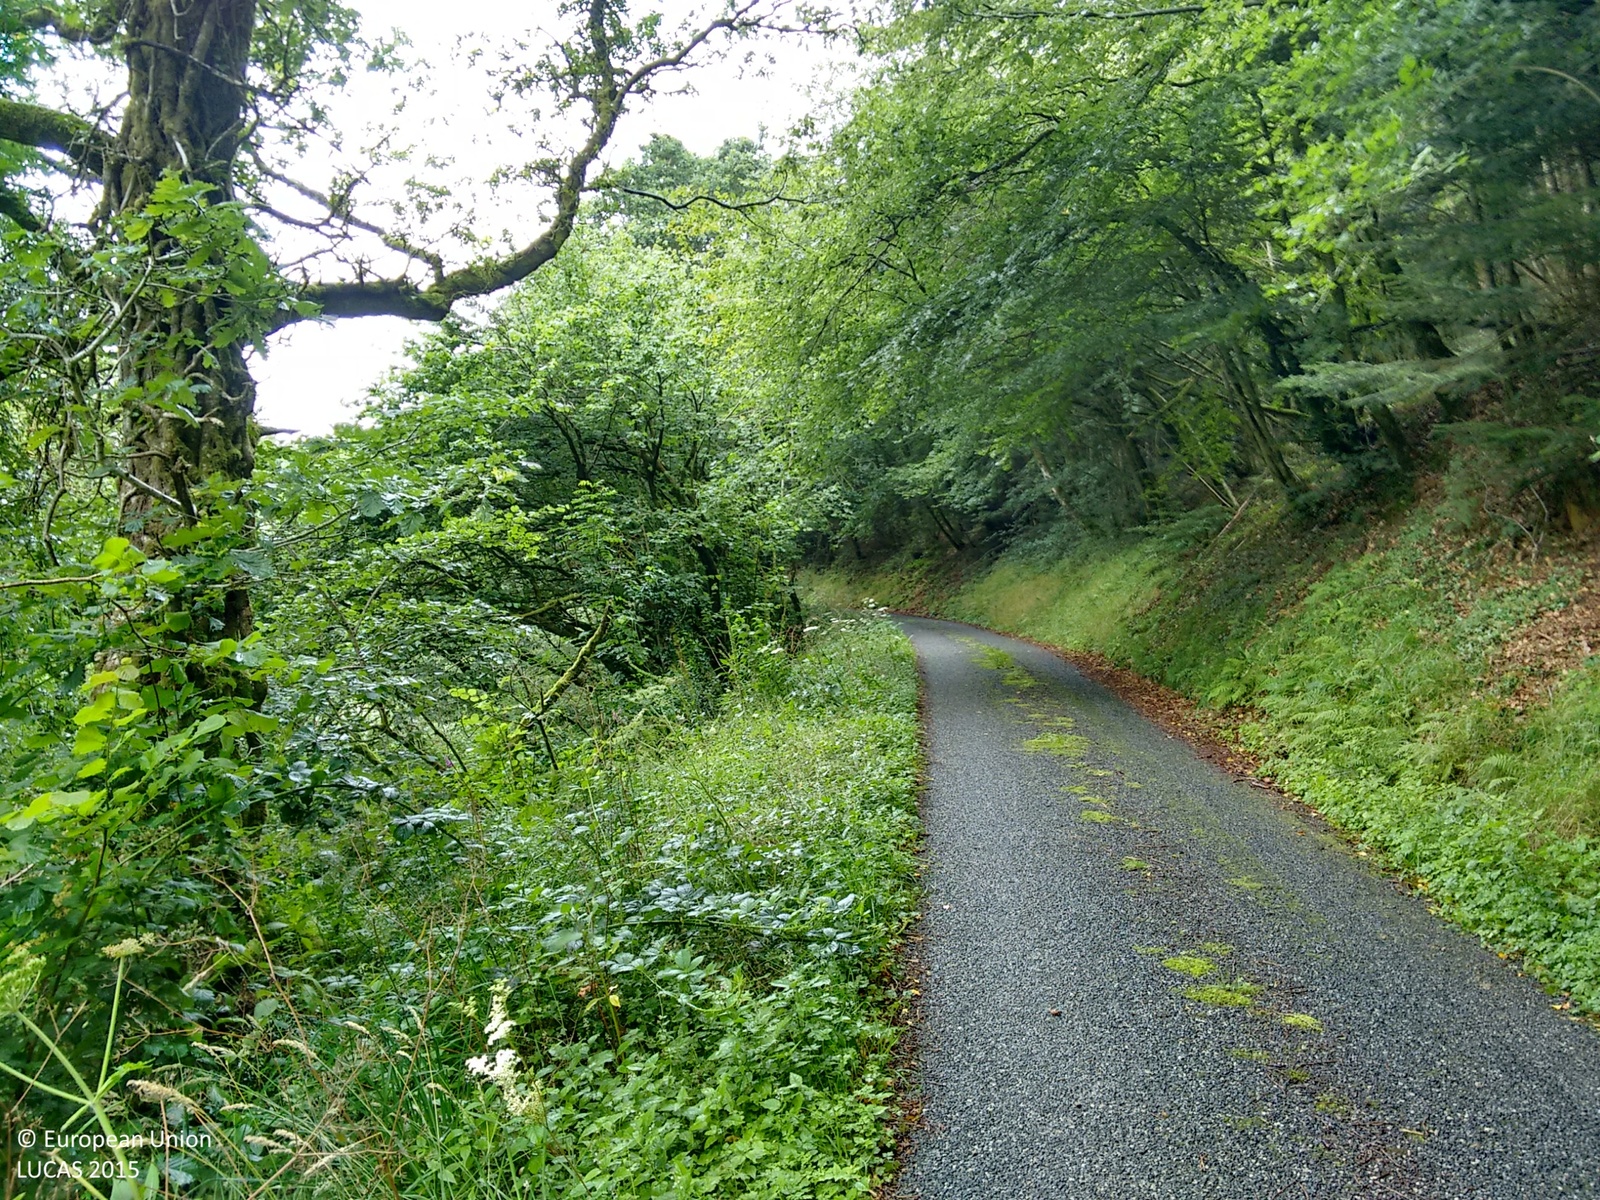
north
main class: Woodland
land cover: Spruce dominated coniferous woodland
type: exotic forest
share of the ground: > 75 %
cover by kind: coniferous forest trees 90 %, shrubs 10 %
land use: Semi-natural and natural areas not in use
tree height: > 5 m
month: August
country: GB
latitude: 51.9001
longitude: -4.5083
